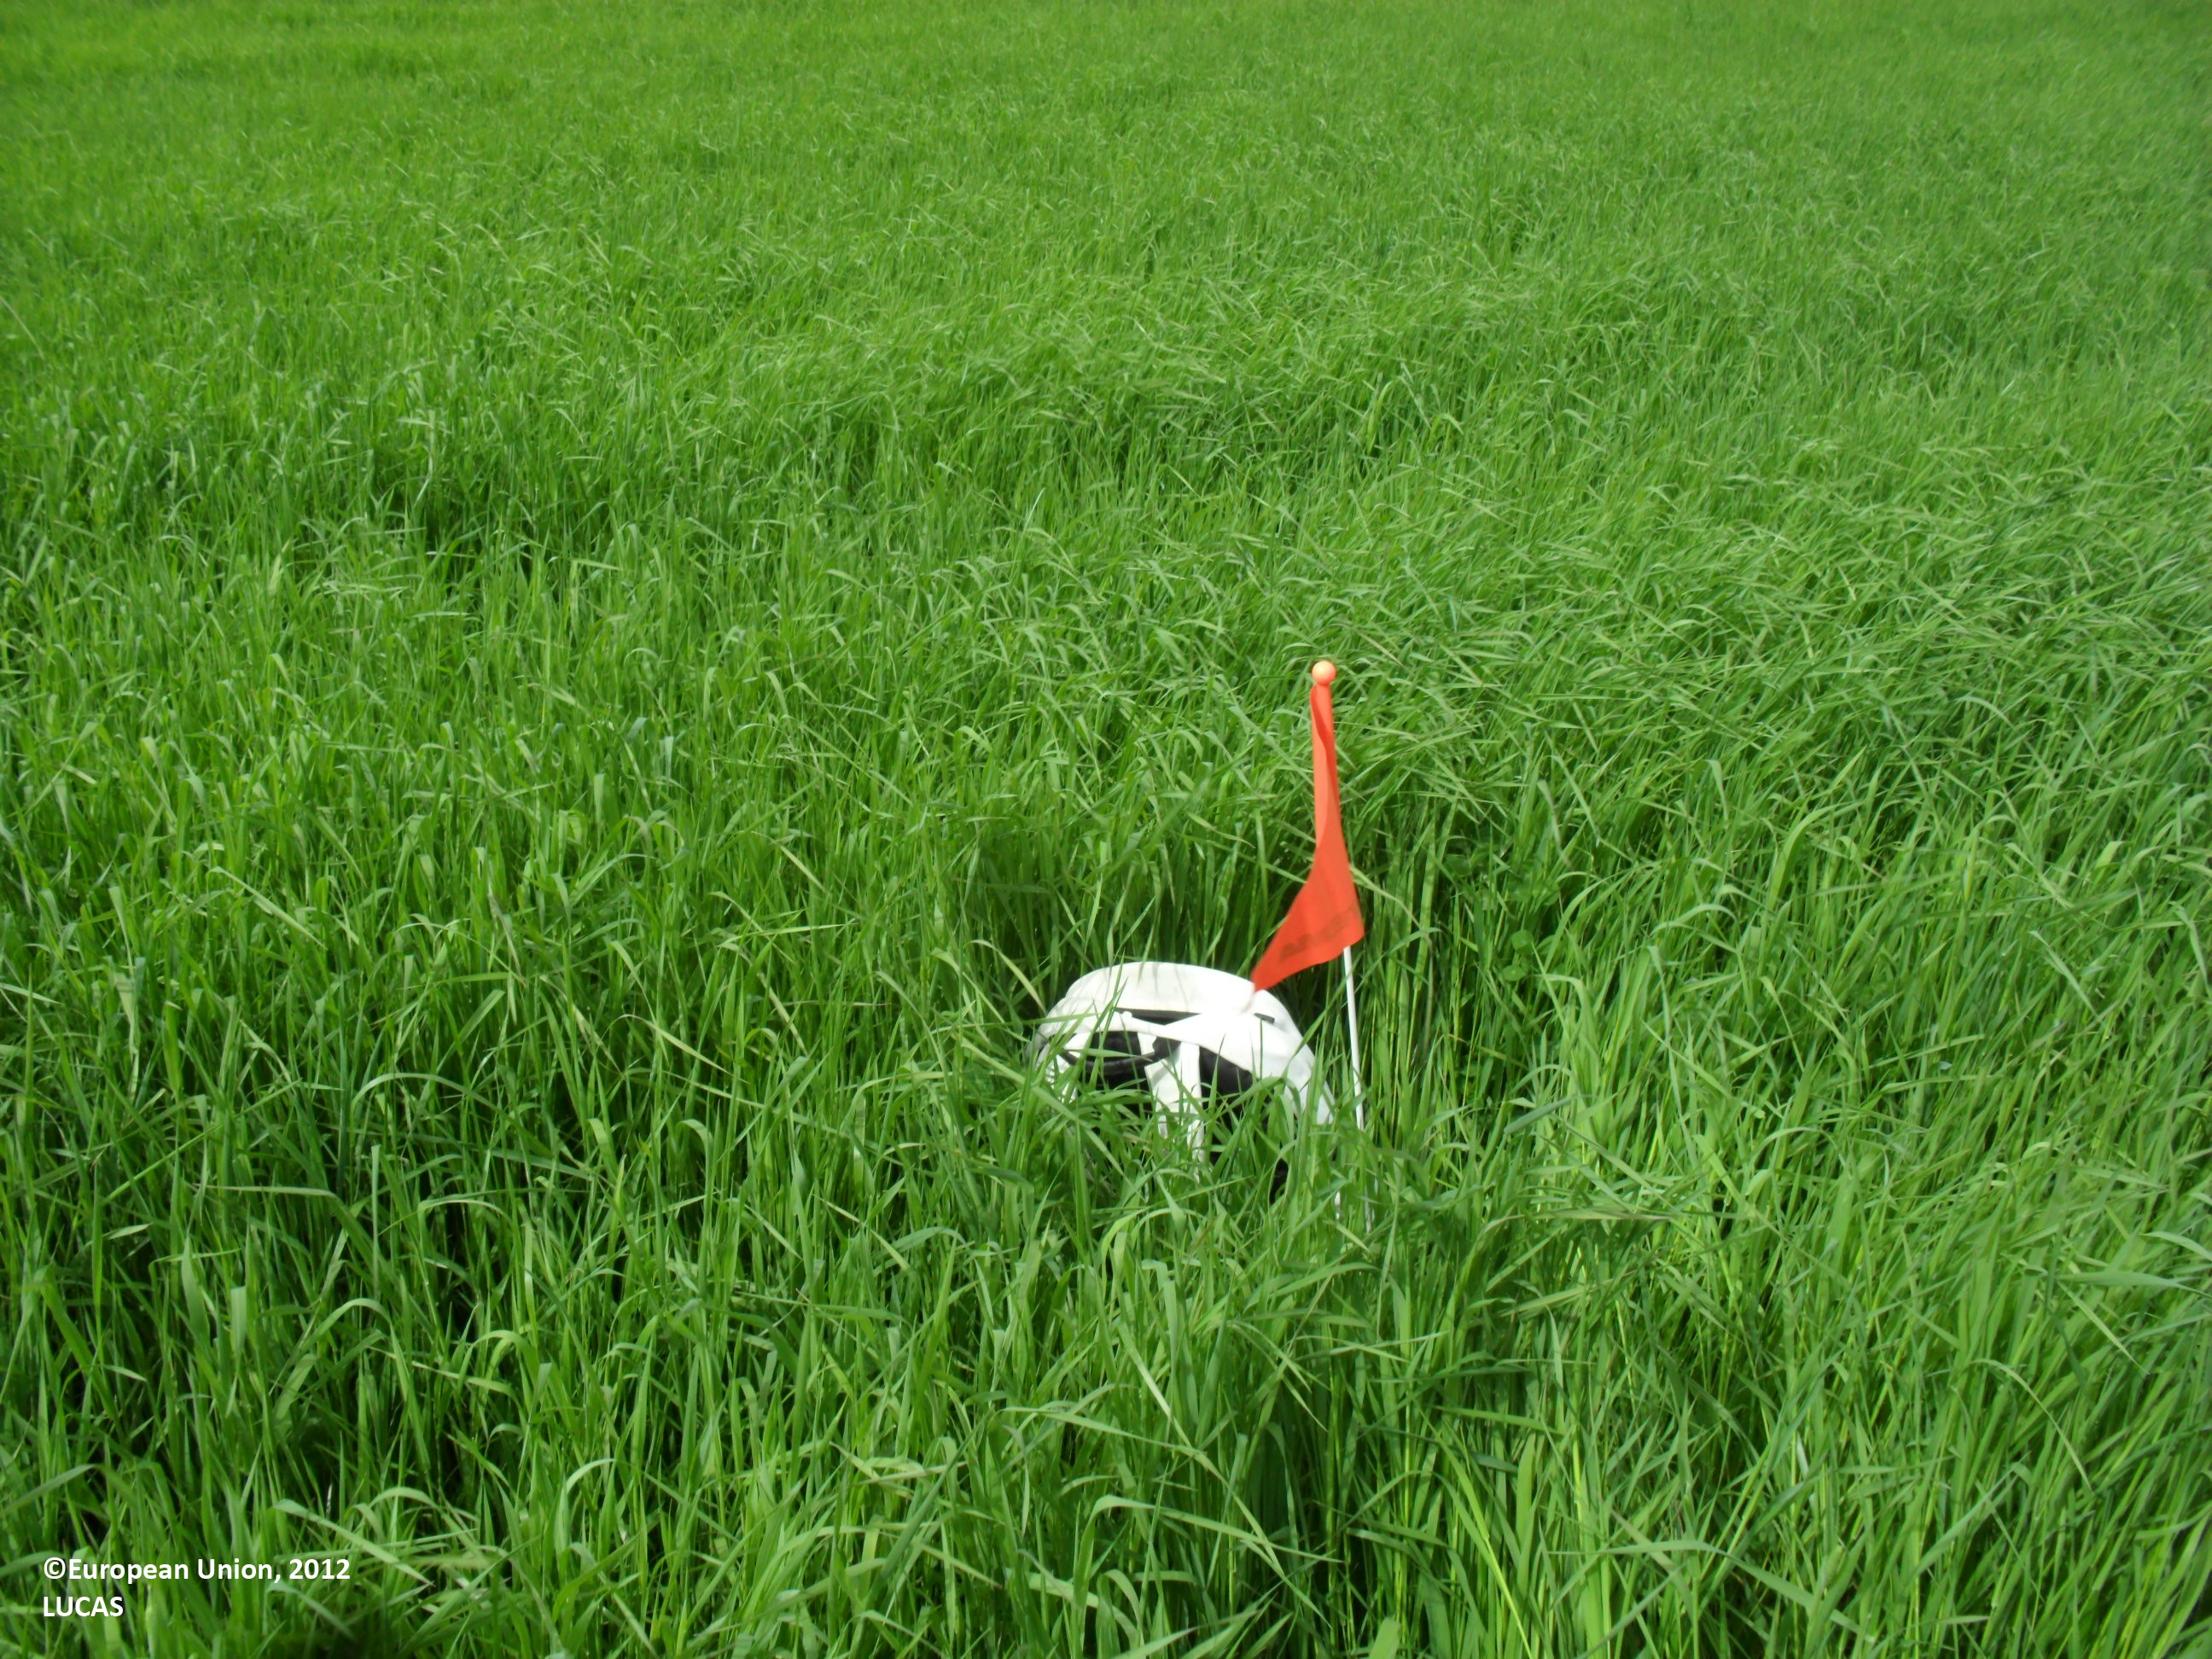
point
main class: Cropland
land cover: Temporary grasslands
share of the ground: > 75 %
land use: Agriculture (excluding fallow land and kitchen gardens)
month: June
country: FI
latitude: 62.7512
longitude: 23.5188
